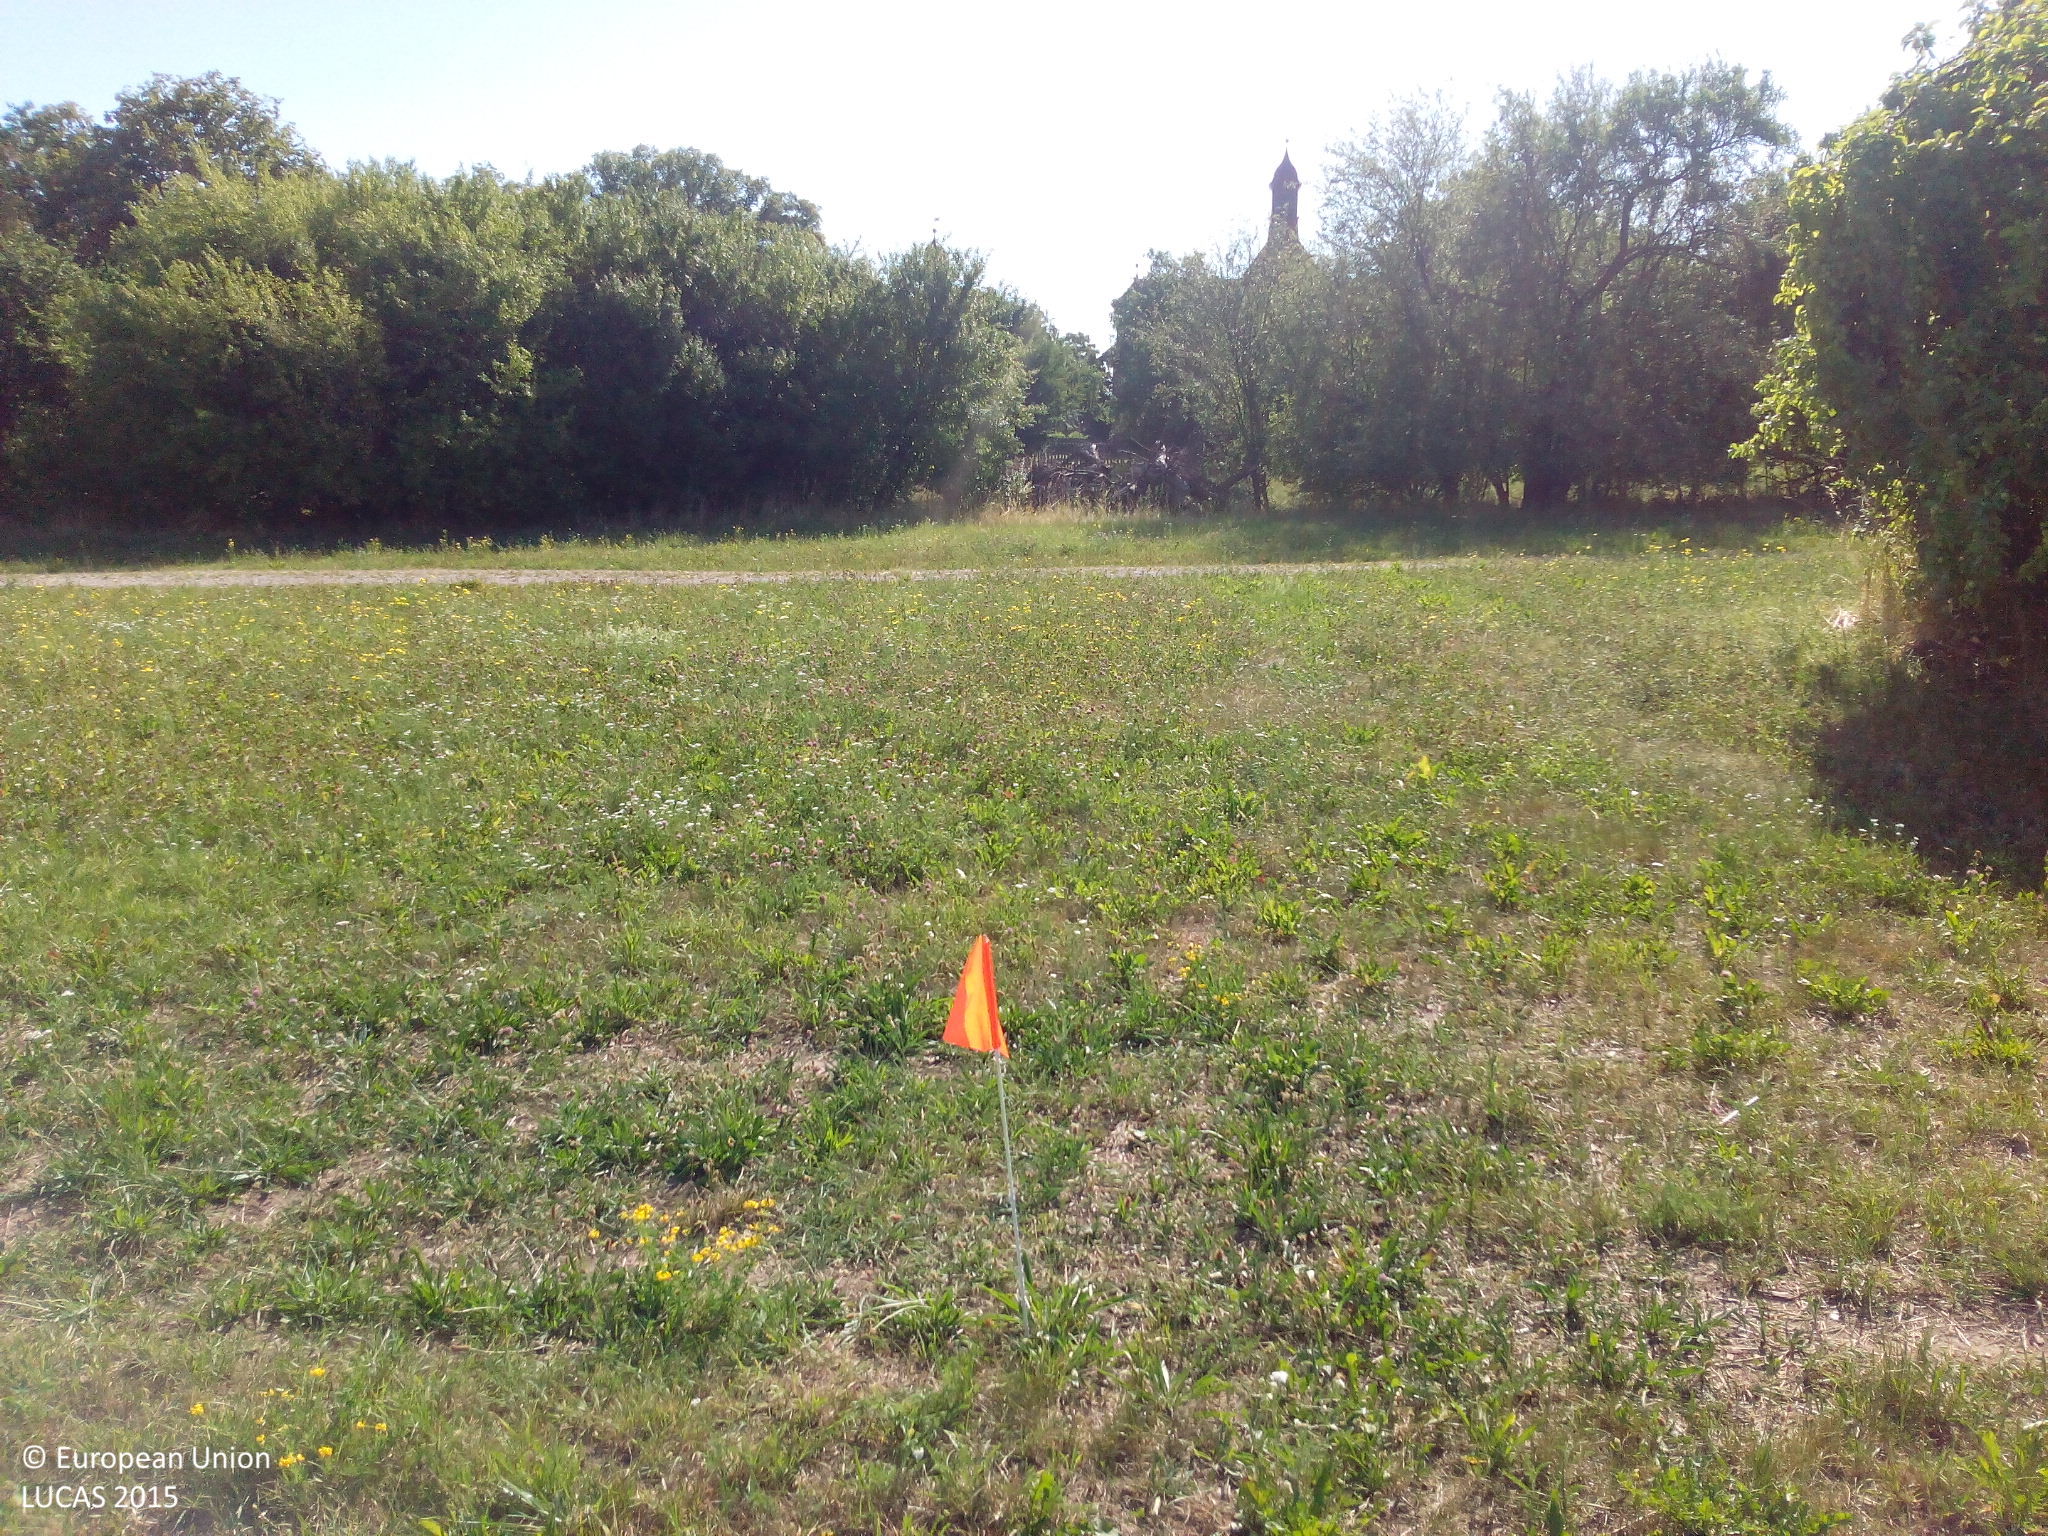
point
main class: Cropland
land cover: Apple fruit
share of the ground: < 10 %
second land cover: Grassland without tree/shrub cover
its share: > 75 %
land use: Agriculture (excluding fallow land and kitchen gardens)
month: July
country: DE
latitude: 49.4071
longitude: 10.9230
